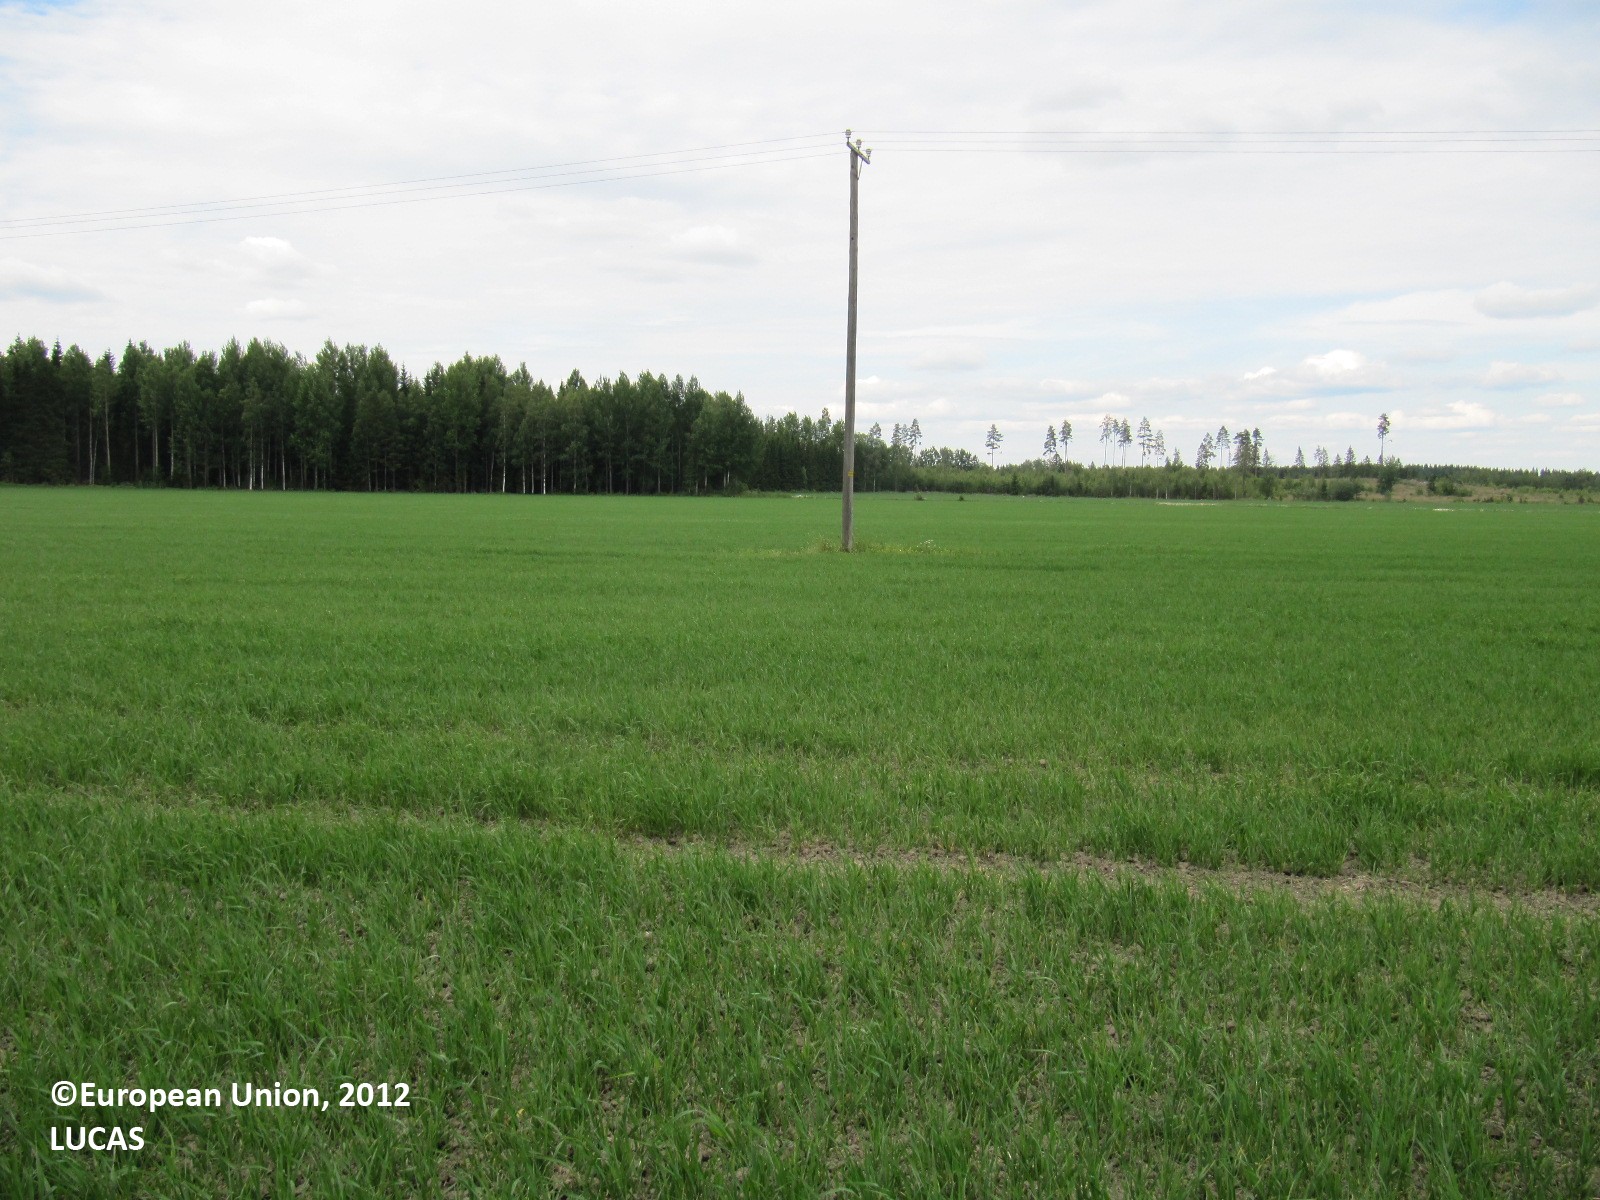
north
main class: Cropland
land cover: Barley
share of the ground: > 75 %
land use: Agriculture (excluding fallow land and kitchen gardens)
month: July
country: FI
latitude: 60.8562
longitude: 23.3911
